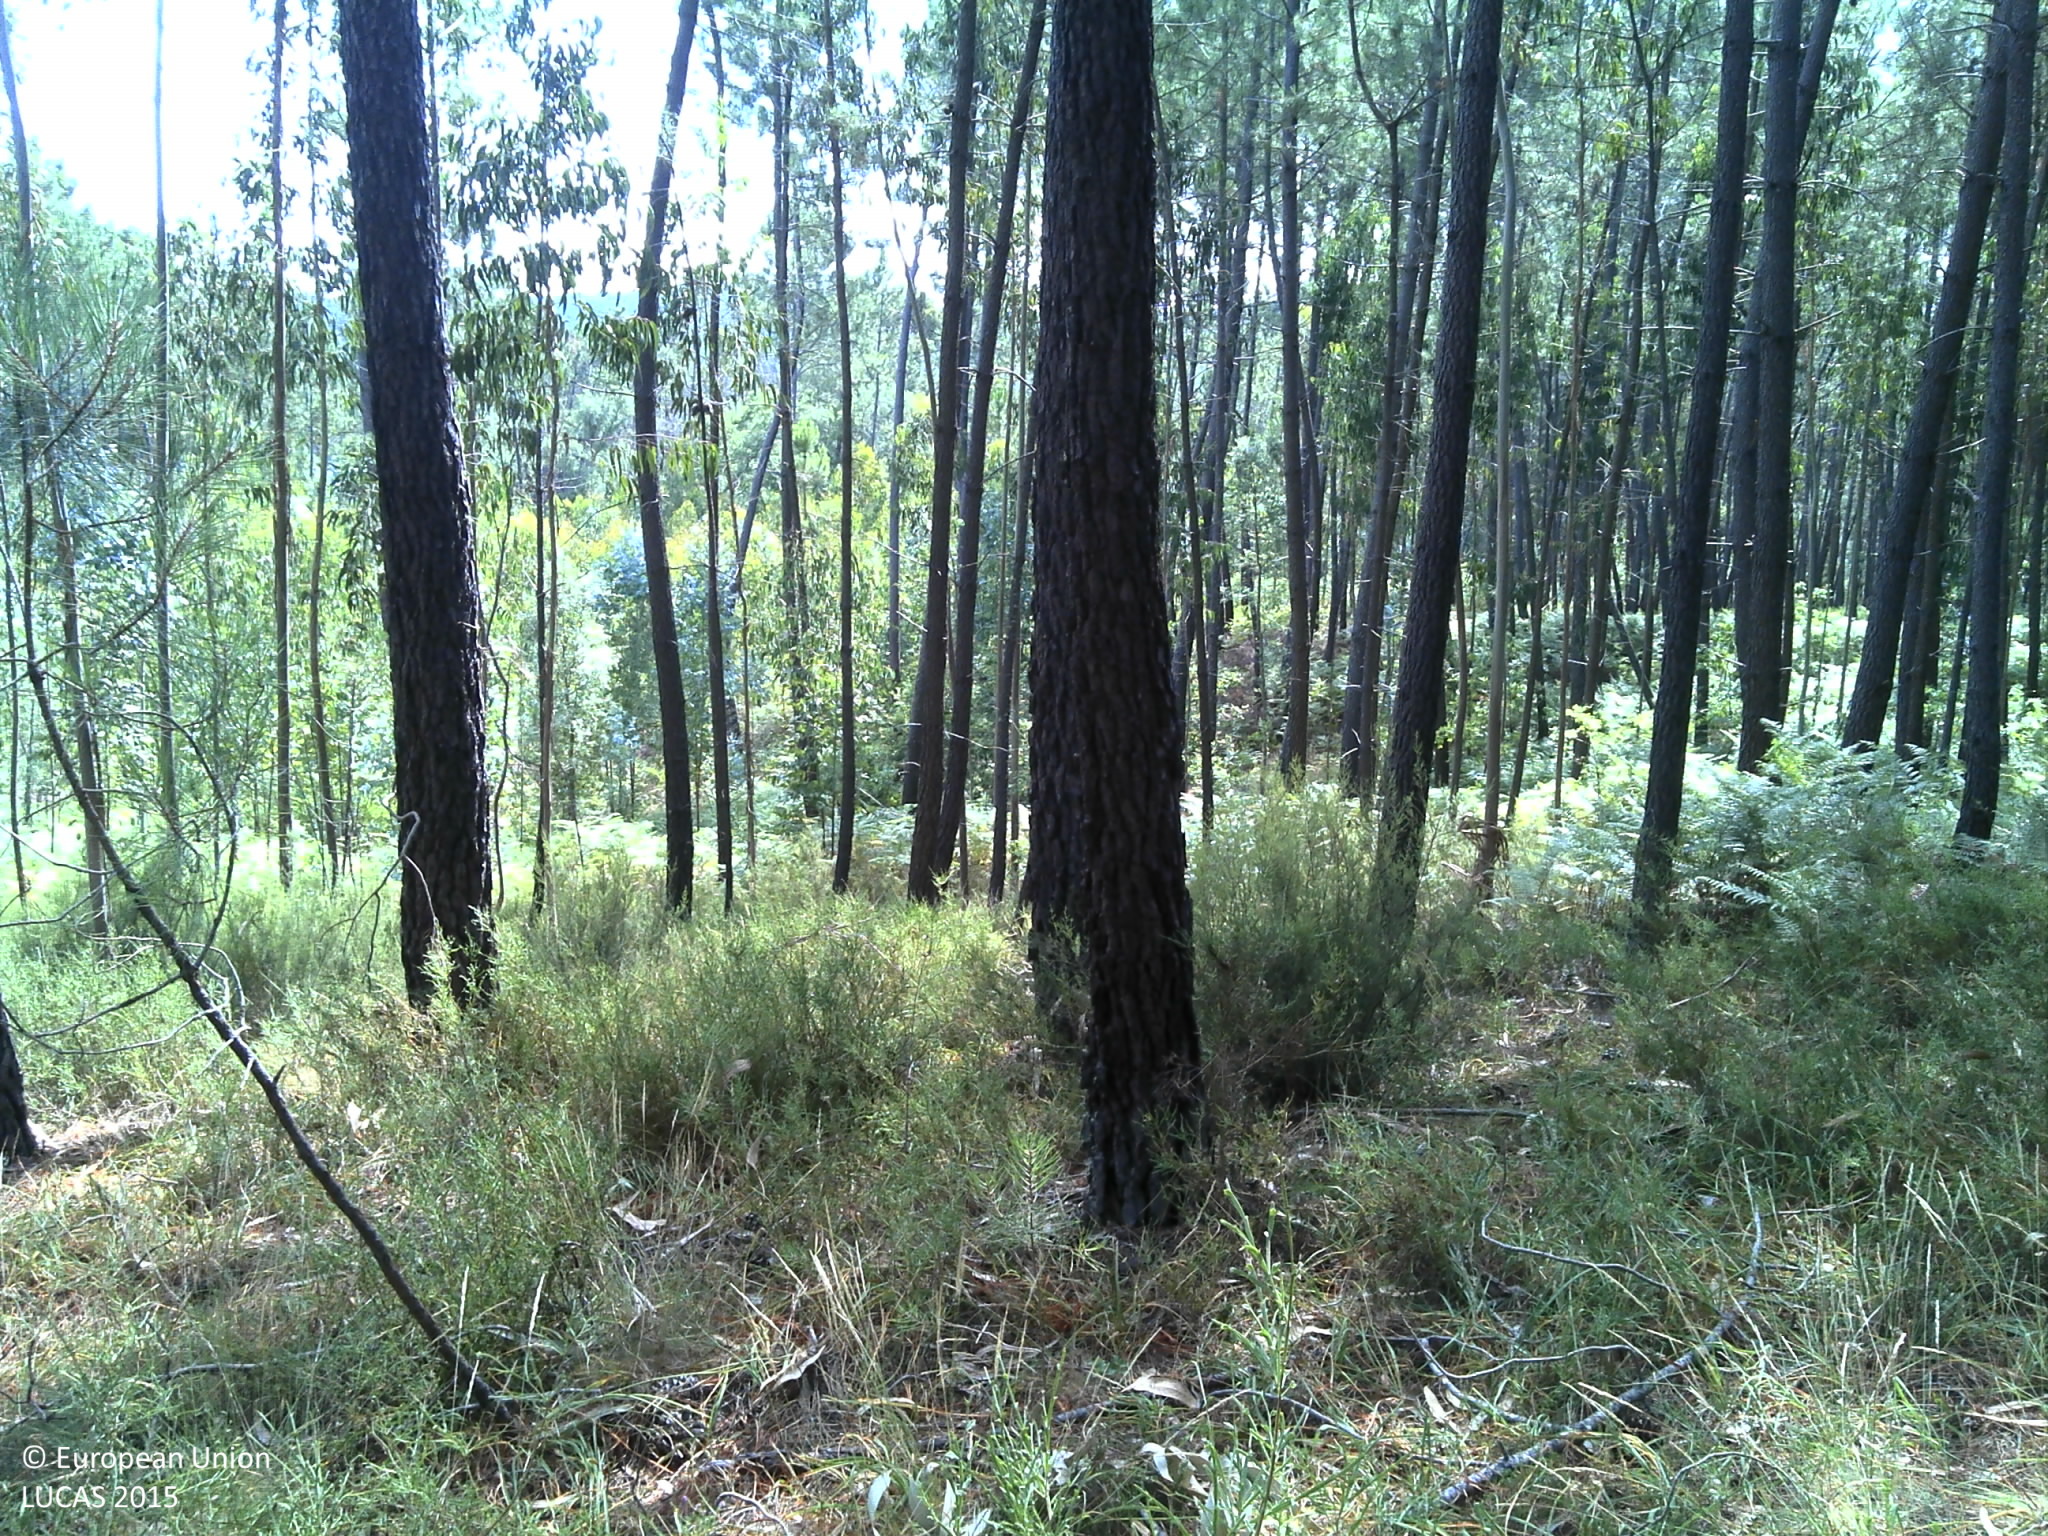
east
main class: Woodland
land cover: Pine dominated mixed woodland
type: coniferous forest of the mediterranean region
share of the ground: 25 - 50 %
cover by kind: shrubs 40 %, coniferous forest trees 15 %, broadleaved forest trees 10 %, consolidated bare surface 10 %, unconsolidated bare surface 10 %
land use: Forestry
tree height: > 5 m
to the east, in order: Pine dominated mixed woodland; Tracks; Pine dominated mixed woodland; Broadleaved woodland
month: July
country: PT
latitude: 39.8959
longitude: -8.1156
